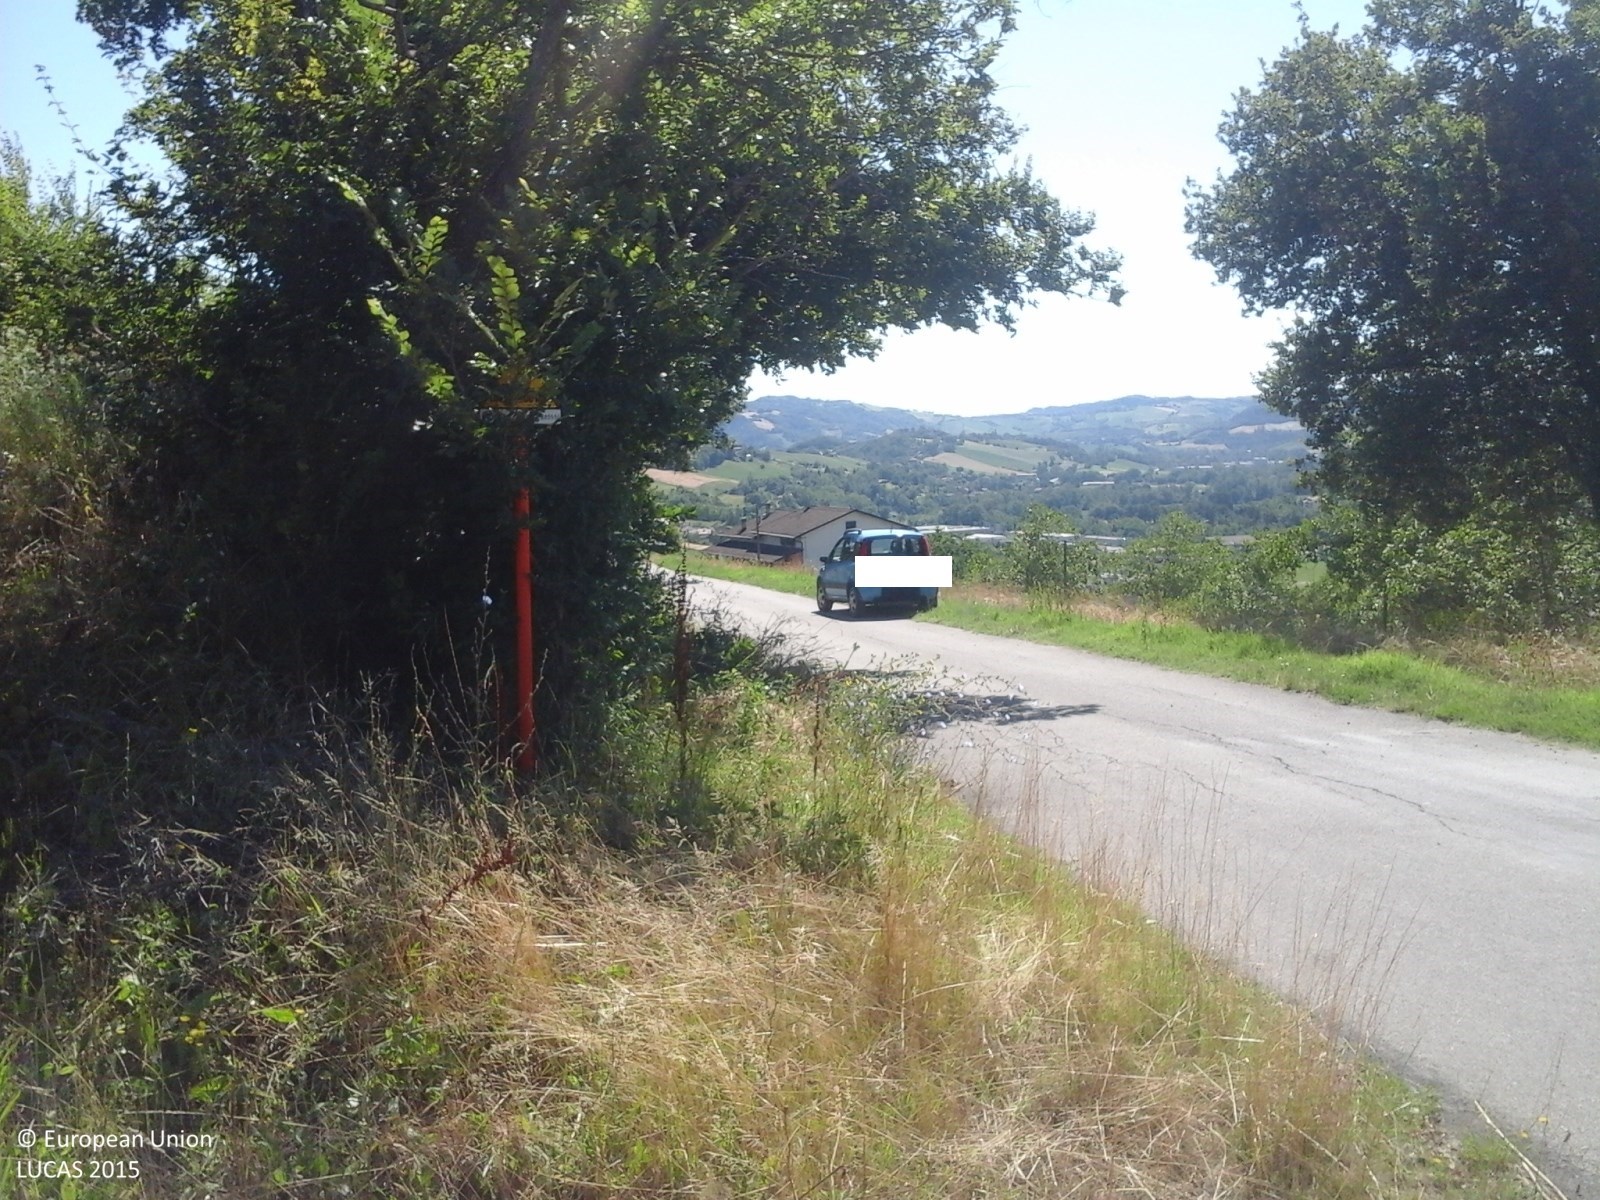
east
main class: Grassland
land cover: Grassland with sparse tree/shrub cover
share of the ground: > 75 %
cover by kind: herbaceous plants 90 %, broadleaved forest trees 5 %, shrubs 5 %
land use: Agriculture (excluding fallow land and kitchen gardens)
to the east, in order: Grassland with sparse tree/shrub cover; Abandoned hedges; Paved roads, cycling and walking lanes; Ditches and canals; Electric lines; Common wheat; Artificial constructions in urban areas; Lucerne
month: June
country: IT
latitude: 44.5471
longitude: 10.6154
